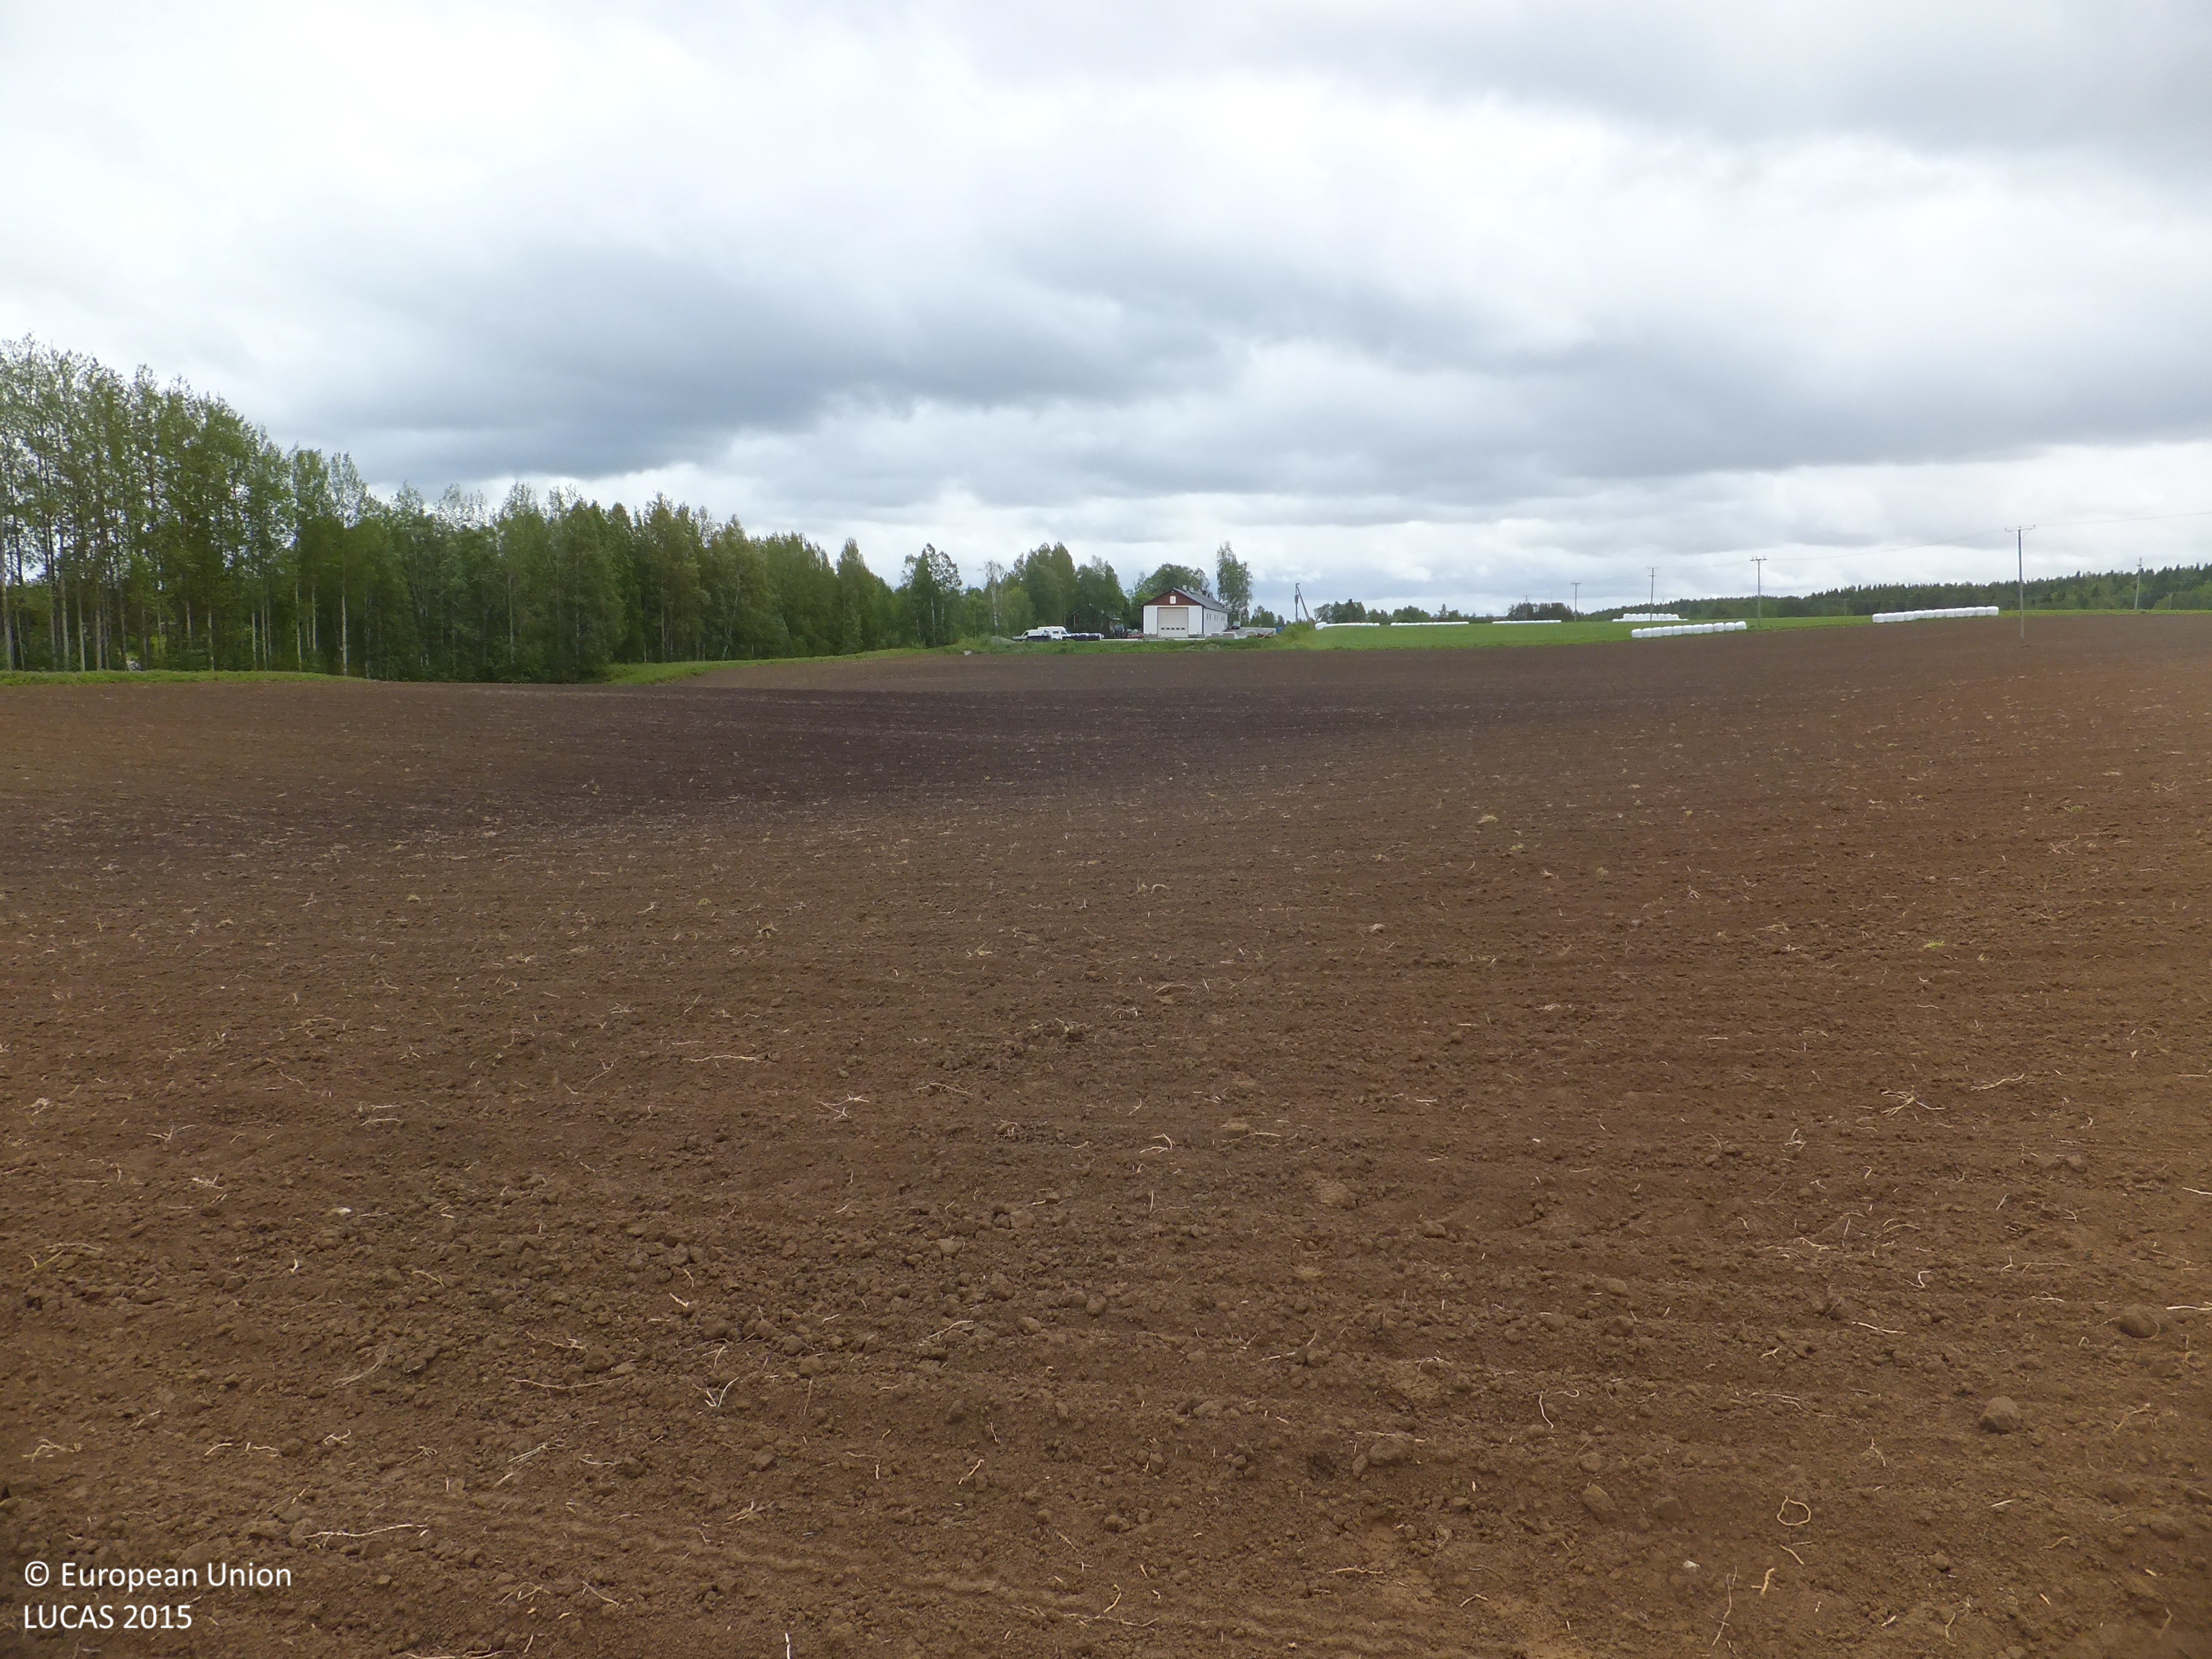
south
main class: Cropland
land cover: Rape and turnip rape
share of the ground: < 10 %
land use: Agriculture (excluding fallow land and kitchen gardens)
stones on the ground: < 10 %
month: June
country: FI
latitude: 63.6455
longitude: 24.3914
